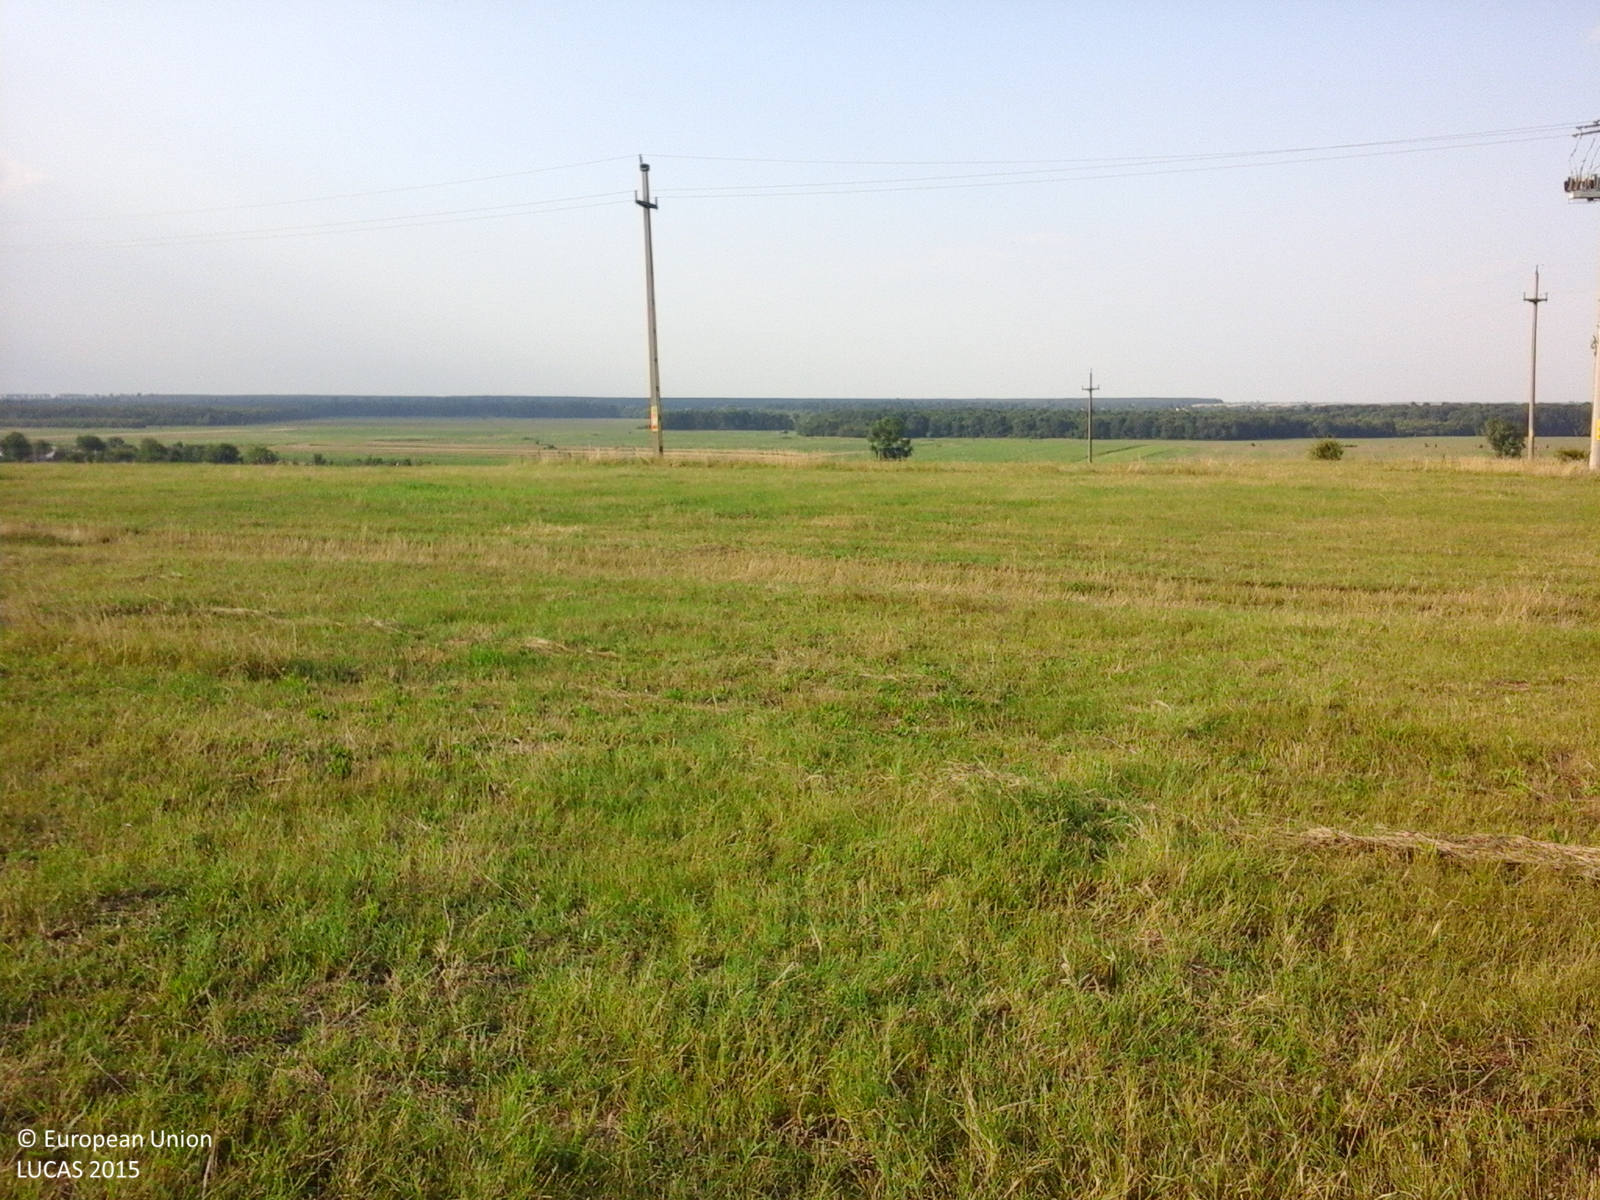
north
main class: Cropland
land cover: Common wheat
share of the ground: > 75 %
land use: Agriculture (excluding fallow land and kitchen gardens)
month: July
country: RO
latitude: 44.1623
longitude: 24.9197
